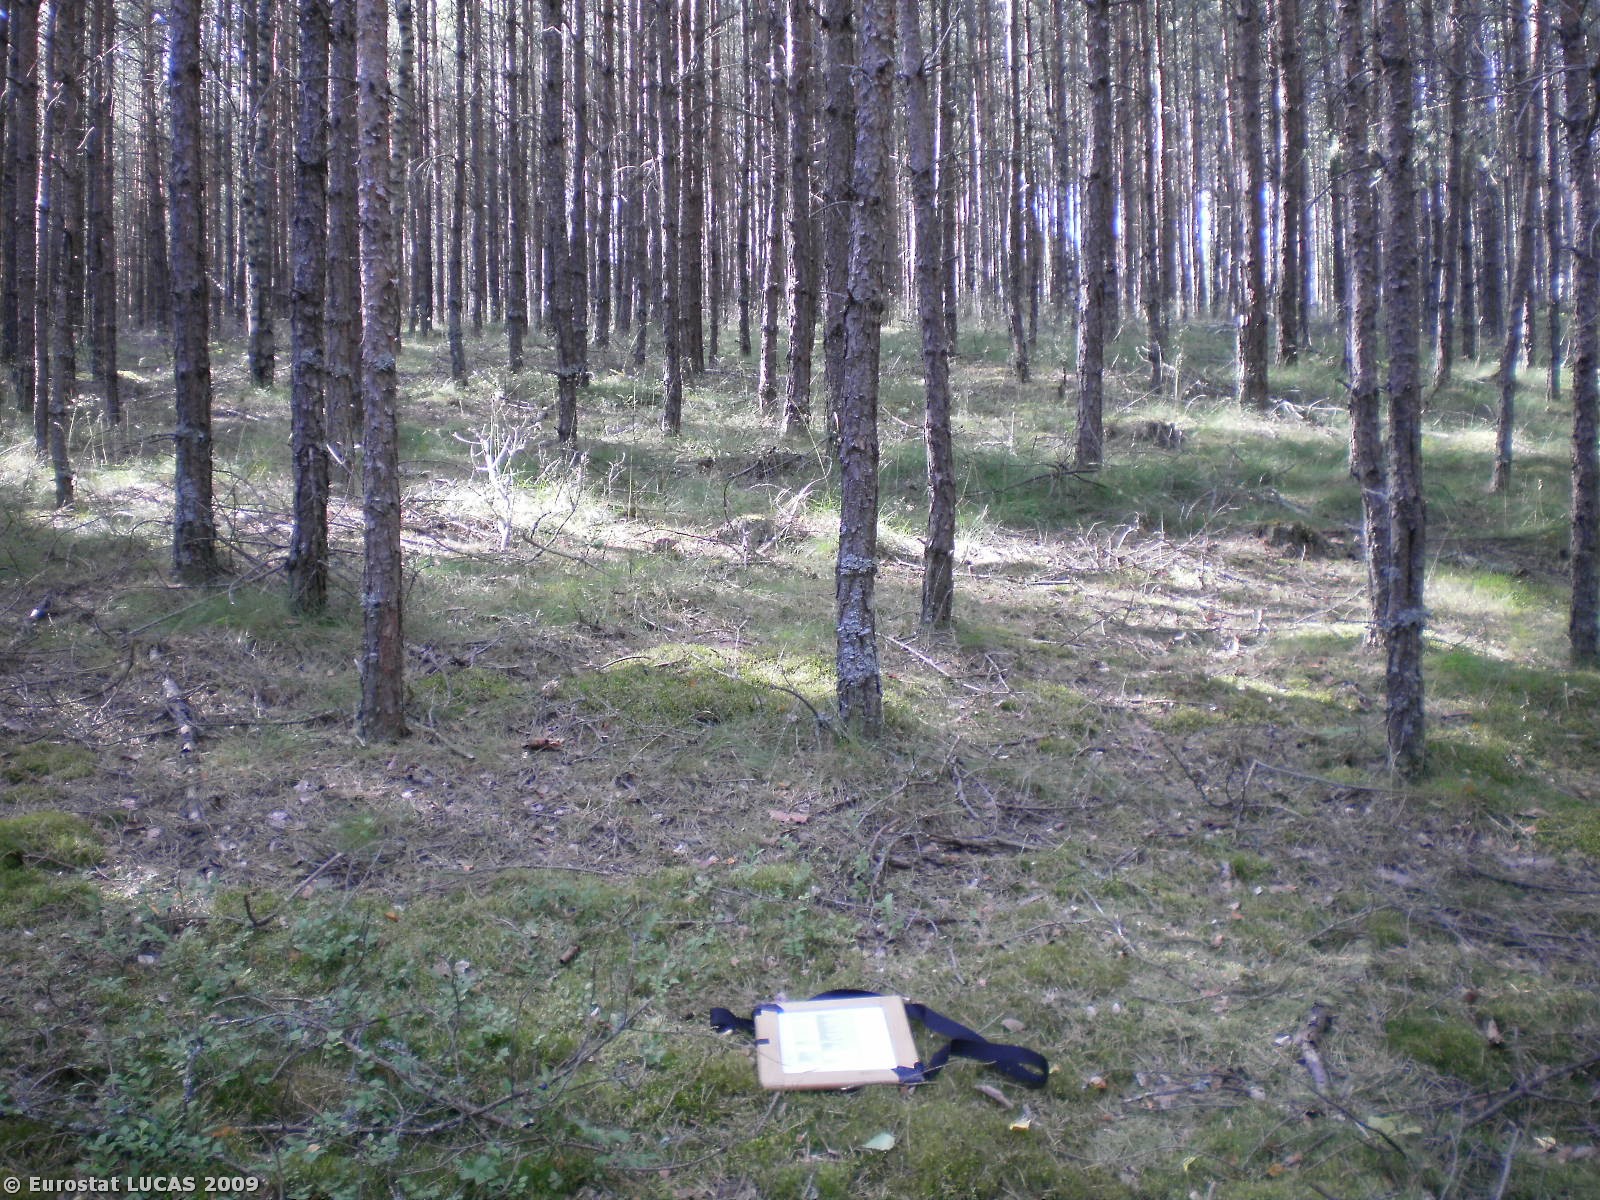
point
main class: Woodland
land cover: Coniferous woodland
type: hemiboreal forest and nemoral coniferous forest and mixed broadleaved-coniferous forest
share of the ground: > 75 %
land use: Forestry
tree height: > 5 m
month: July
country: PL
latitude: 54.0362
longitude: 17.7846
